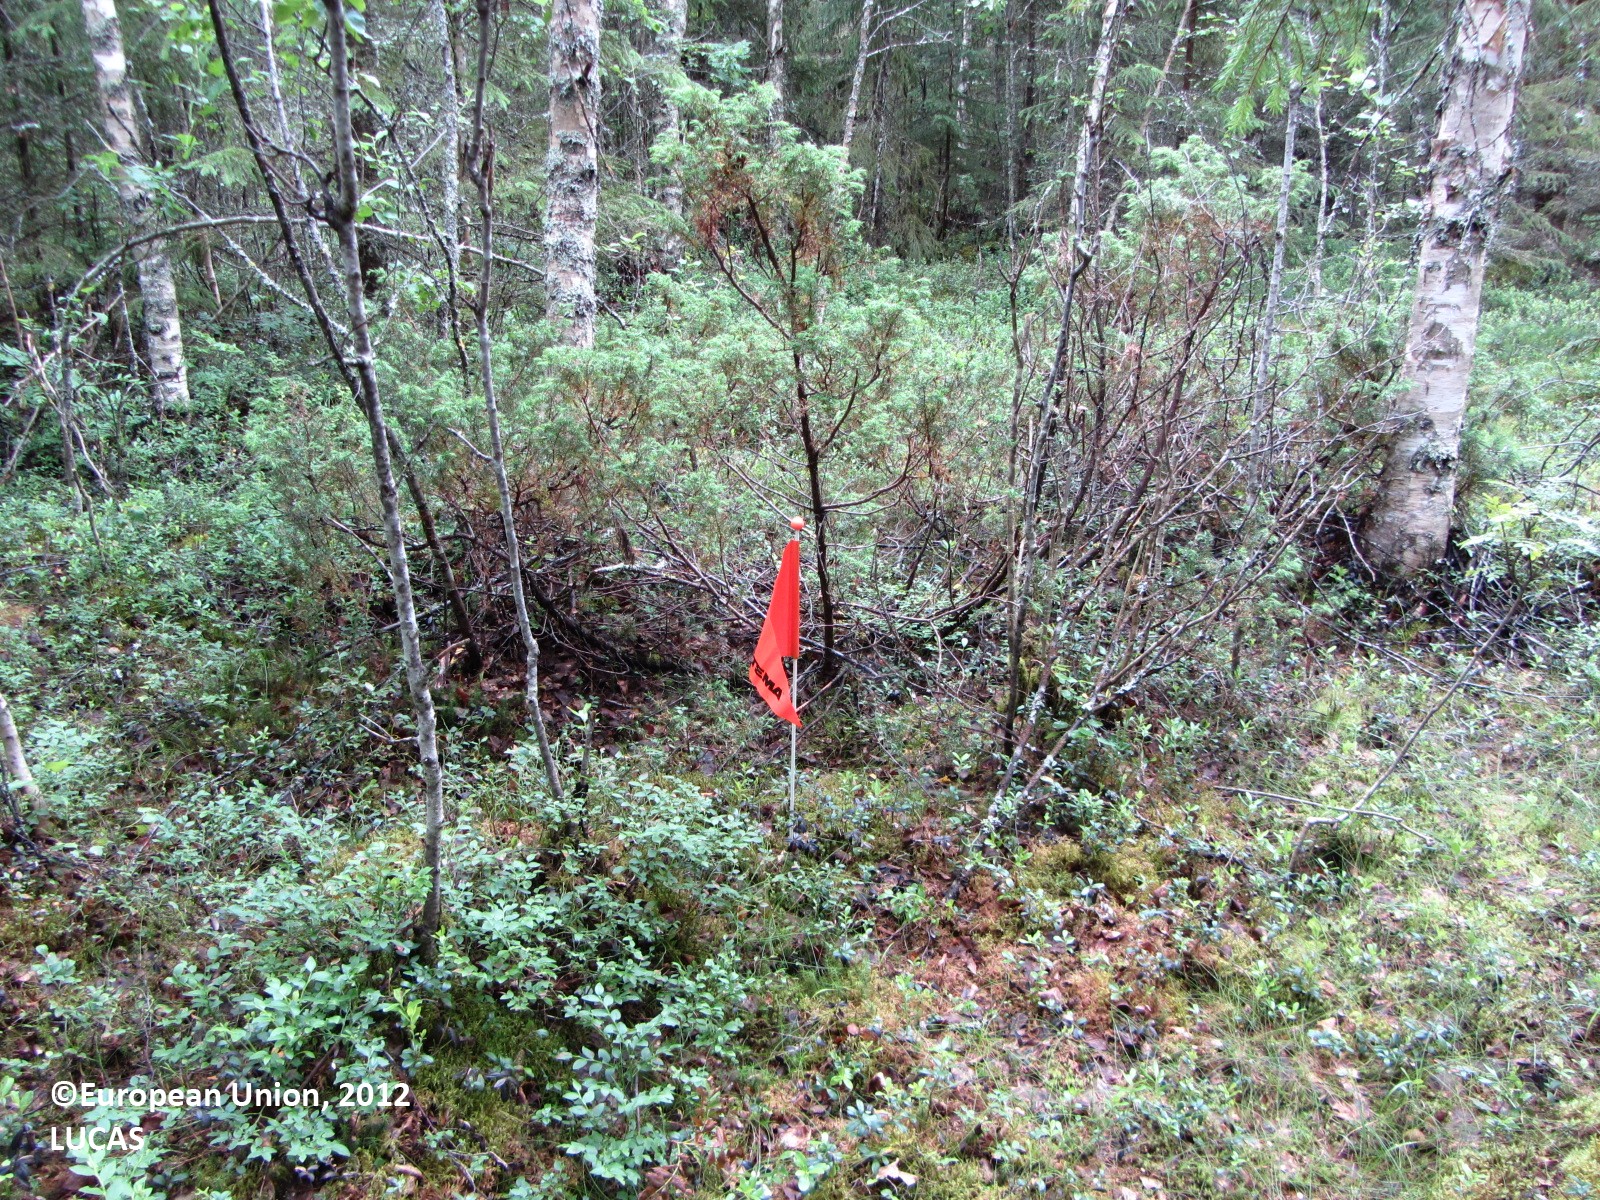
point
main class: Woodland
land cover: Spruce dominated coniferous woodland
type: boreal forest
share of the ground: > 75 %
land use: Forestry
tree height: > 5 m
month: July
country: FI
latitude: 63.8227
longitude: 25.6023
